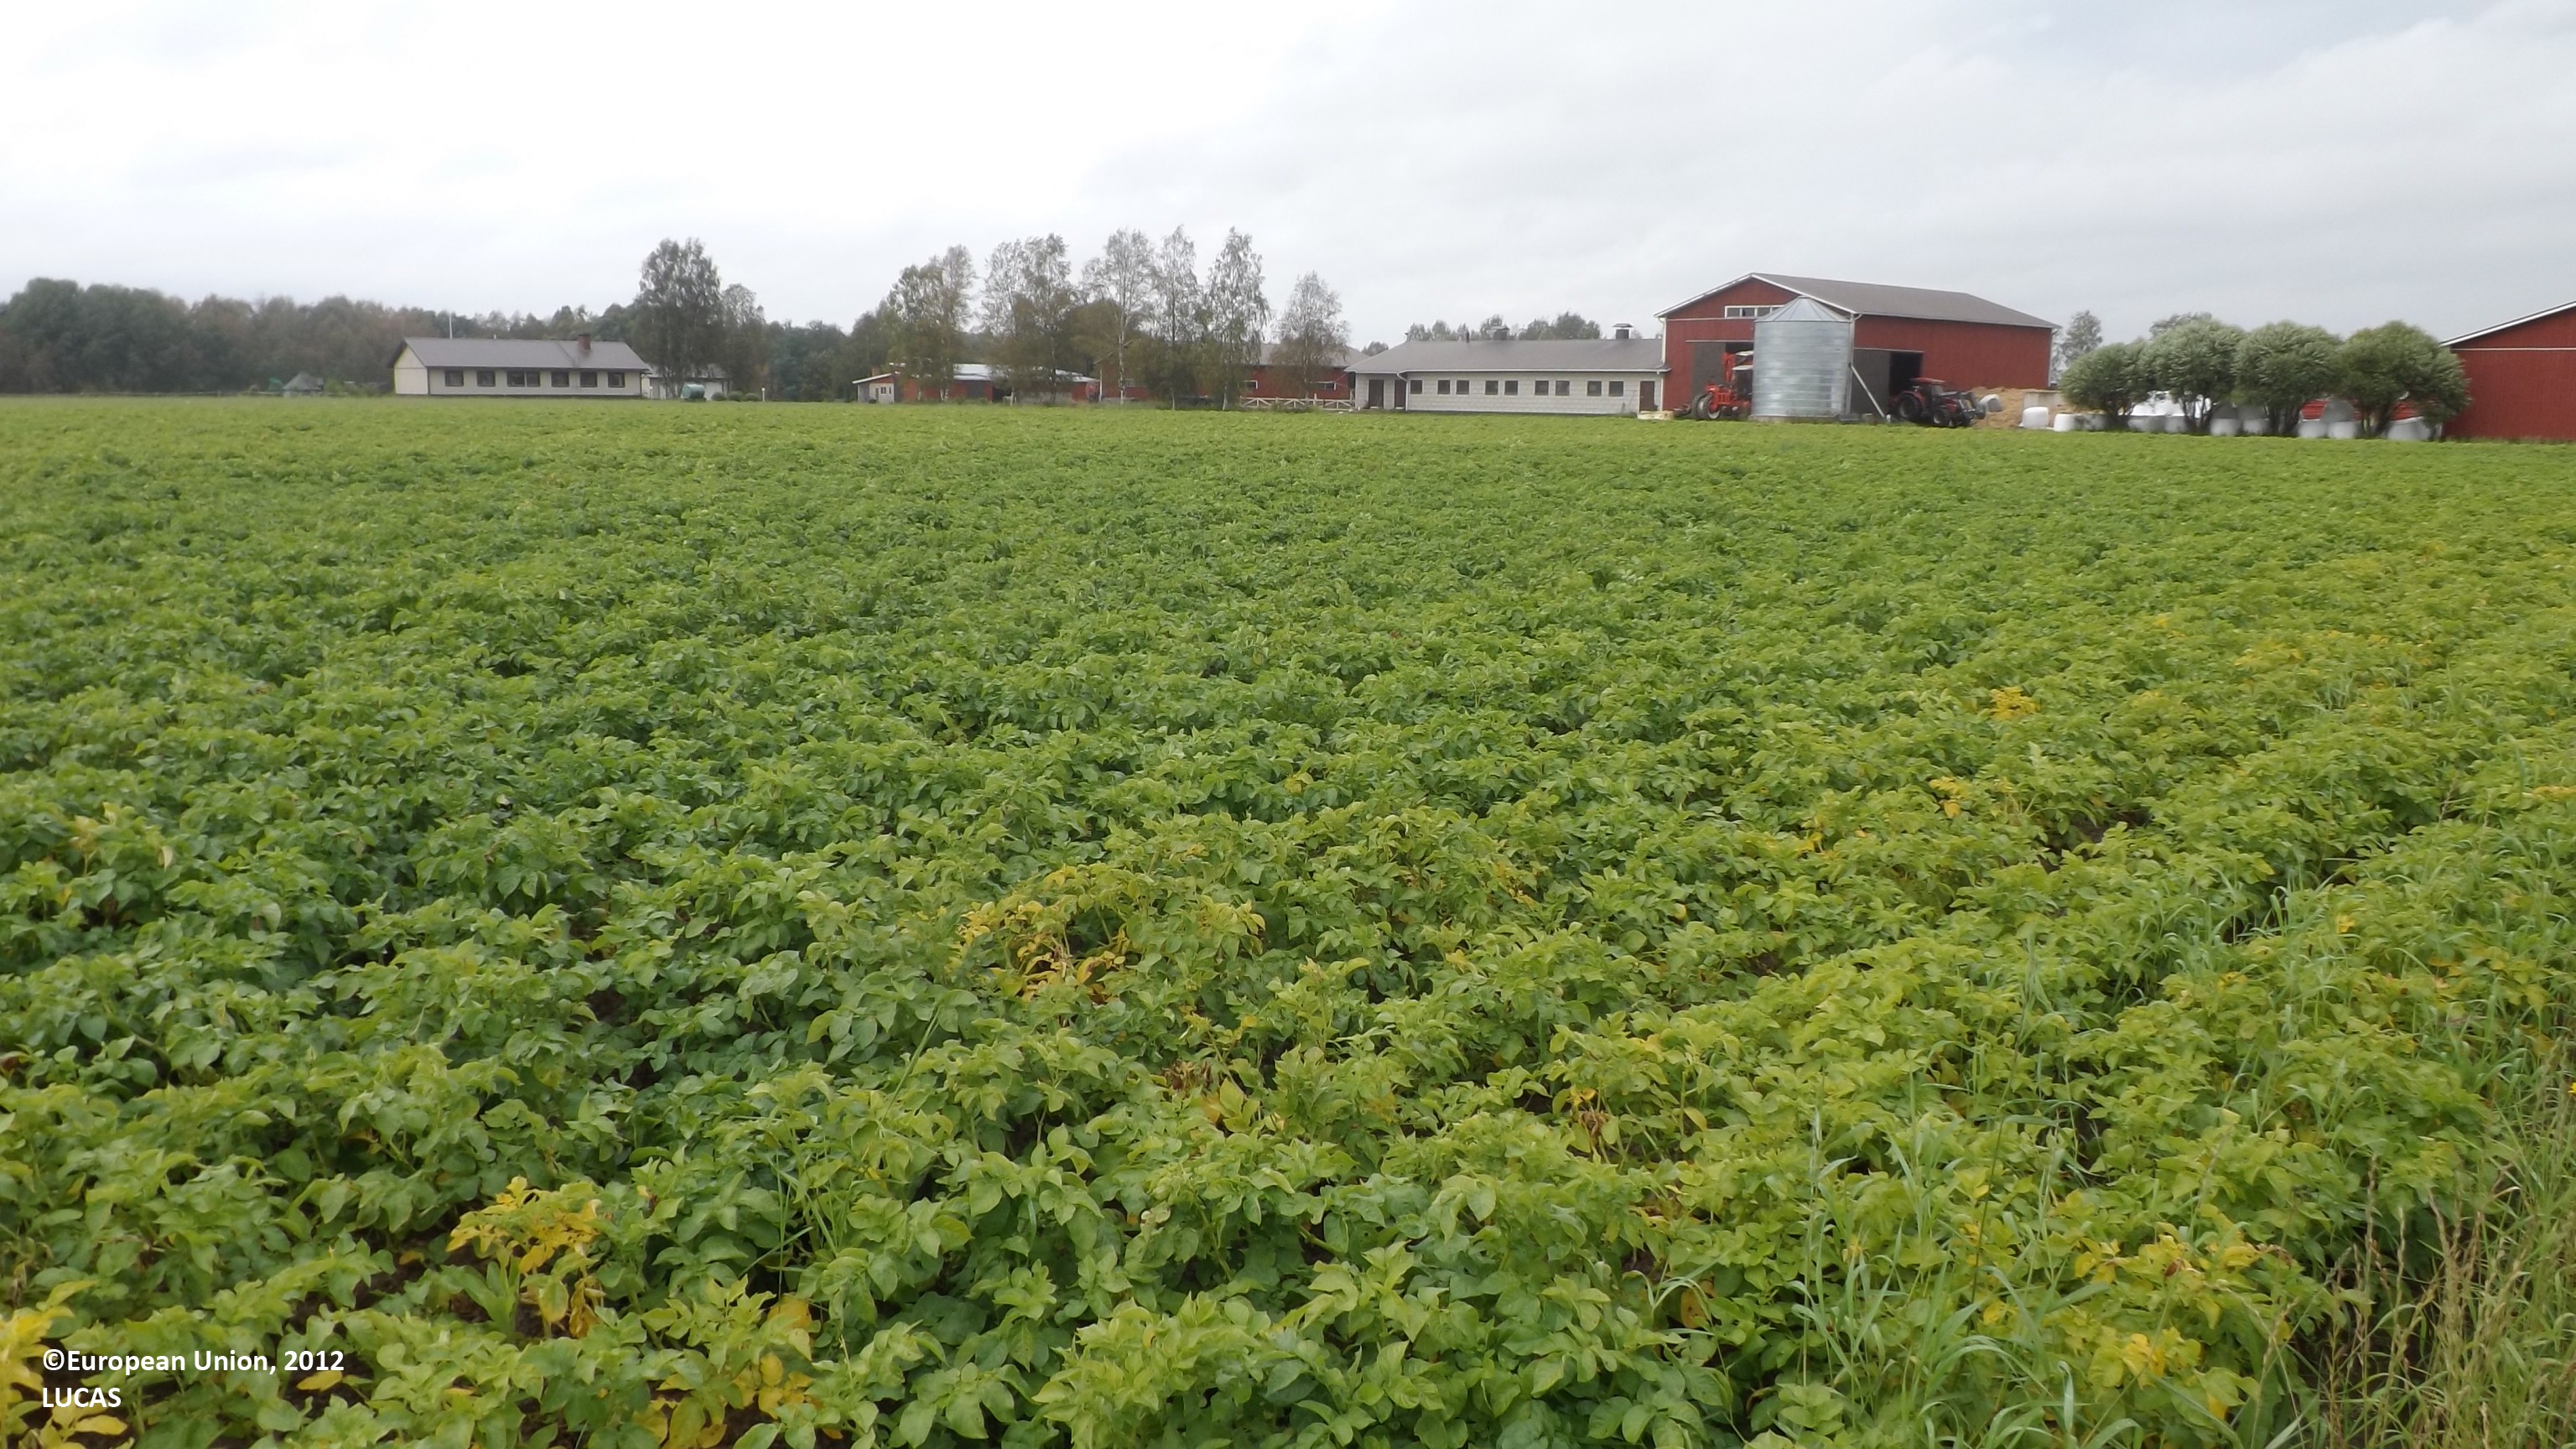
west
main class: Cropland
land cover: Potatoes
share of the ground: > 75 %
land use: Agriculture (excluding fallow land and kitchen gardens)
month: August
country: FI
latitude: 63.8827
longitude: 24.0139
